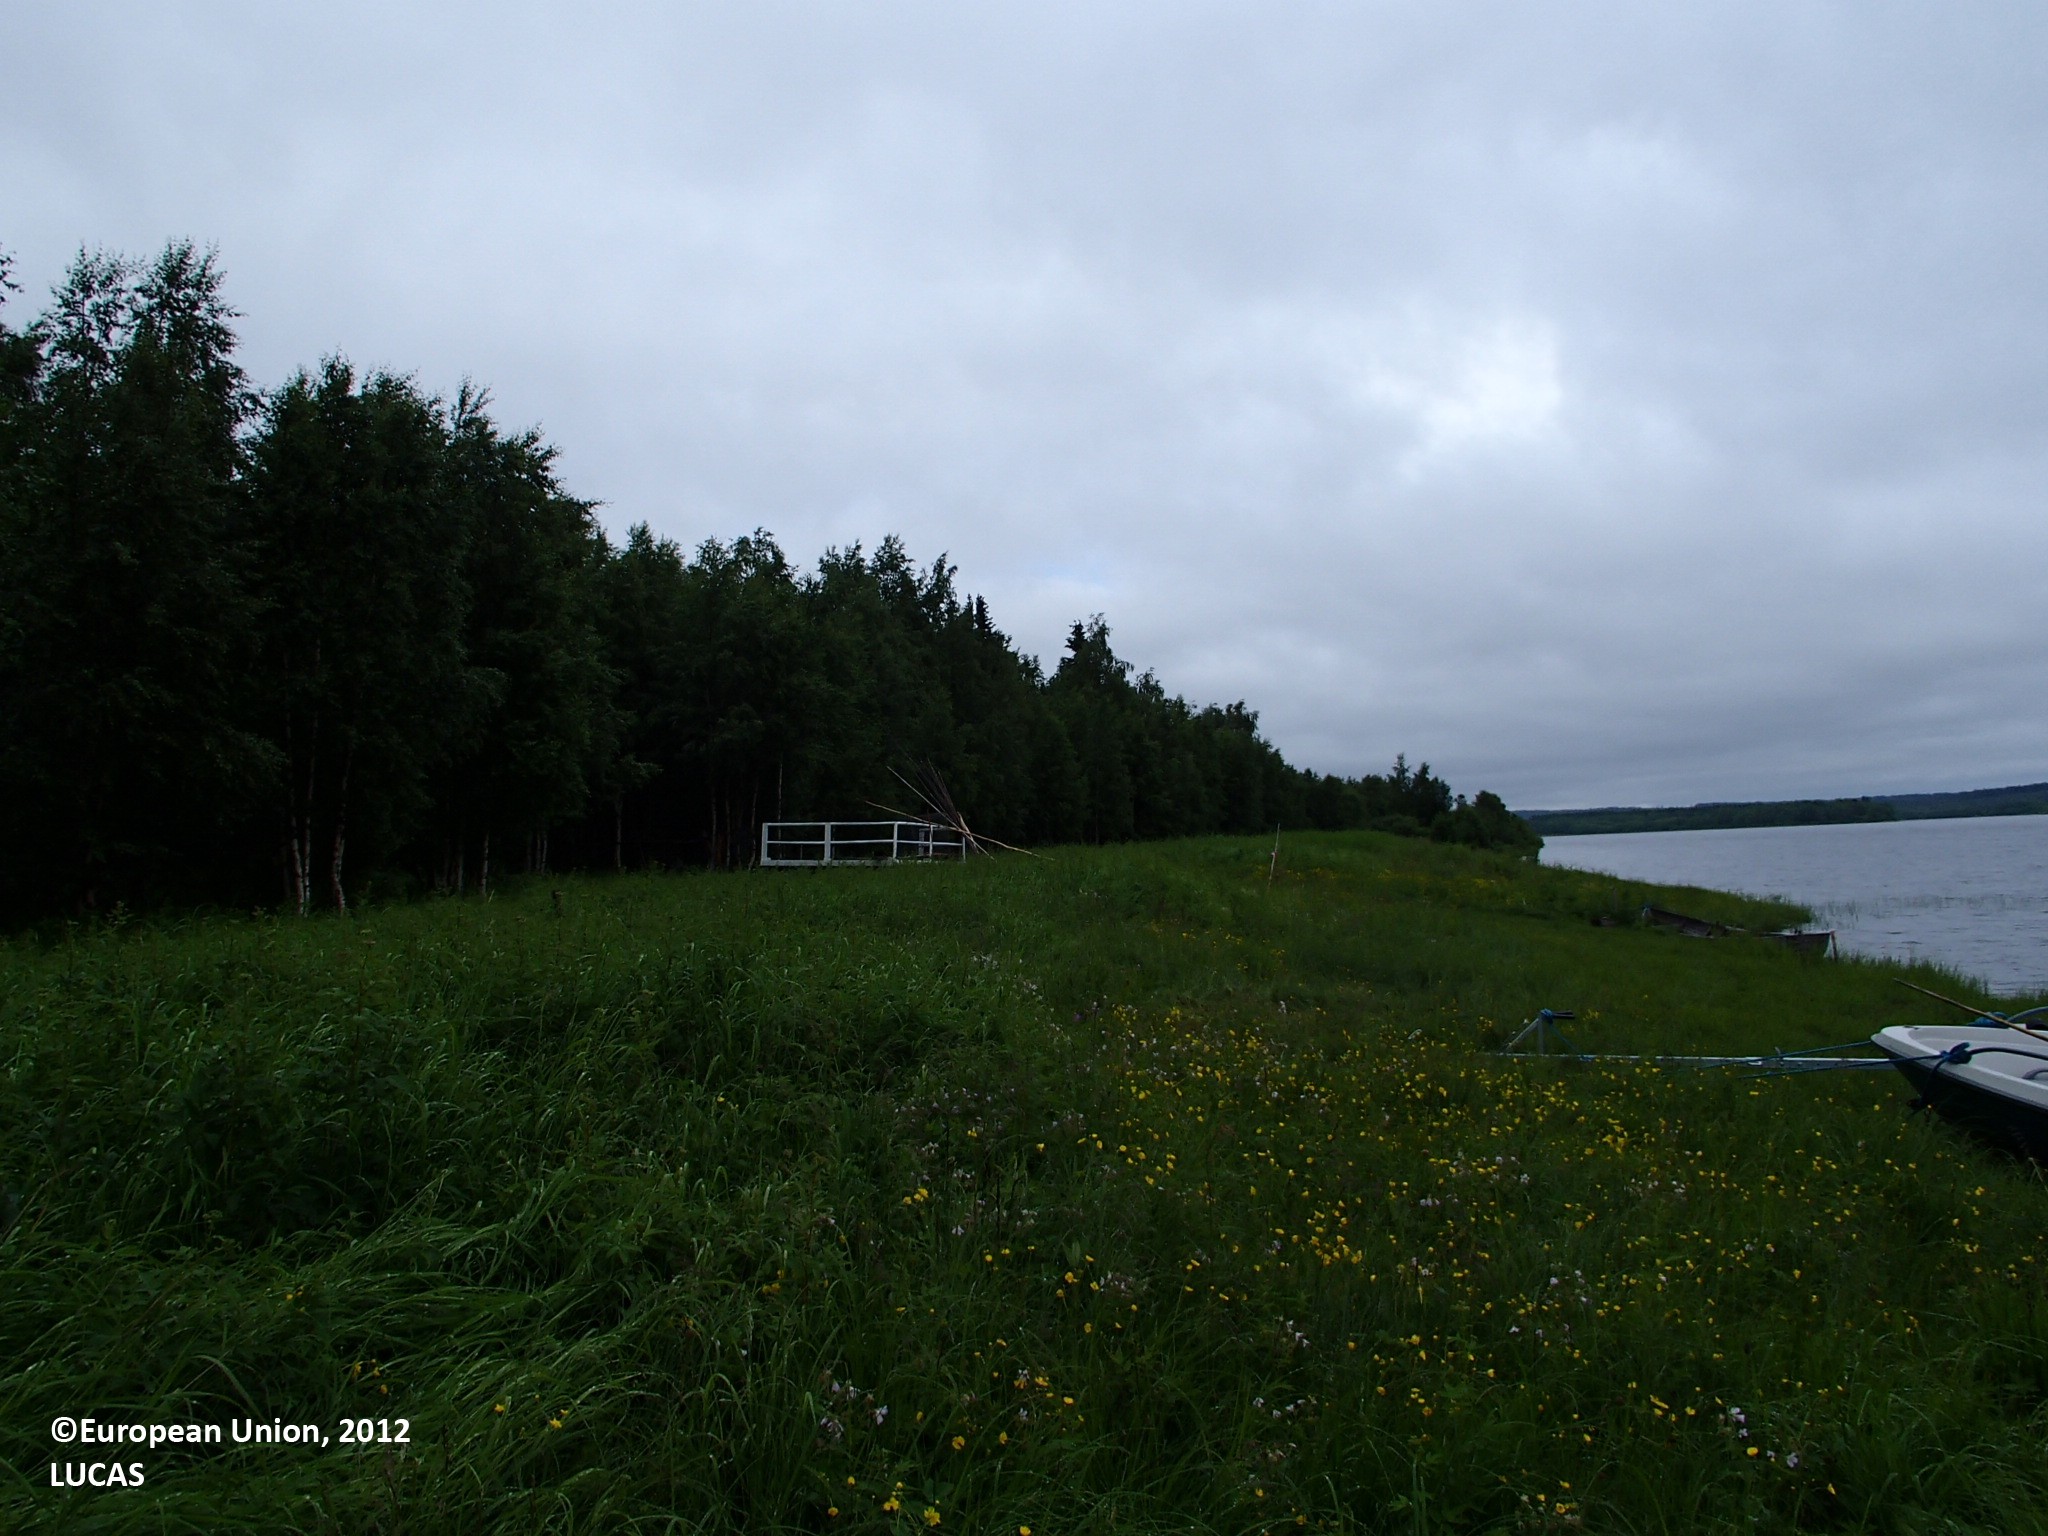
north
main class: Grassland
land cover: Grassland without tree/shrub cover
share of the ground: > 75 %
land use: Amenities, museums, leisure
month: July
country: FI
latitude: 66.9875
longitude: 27.5522
